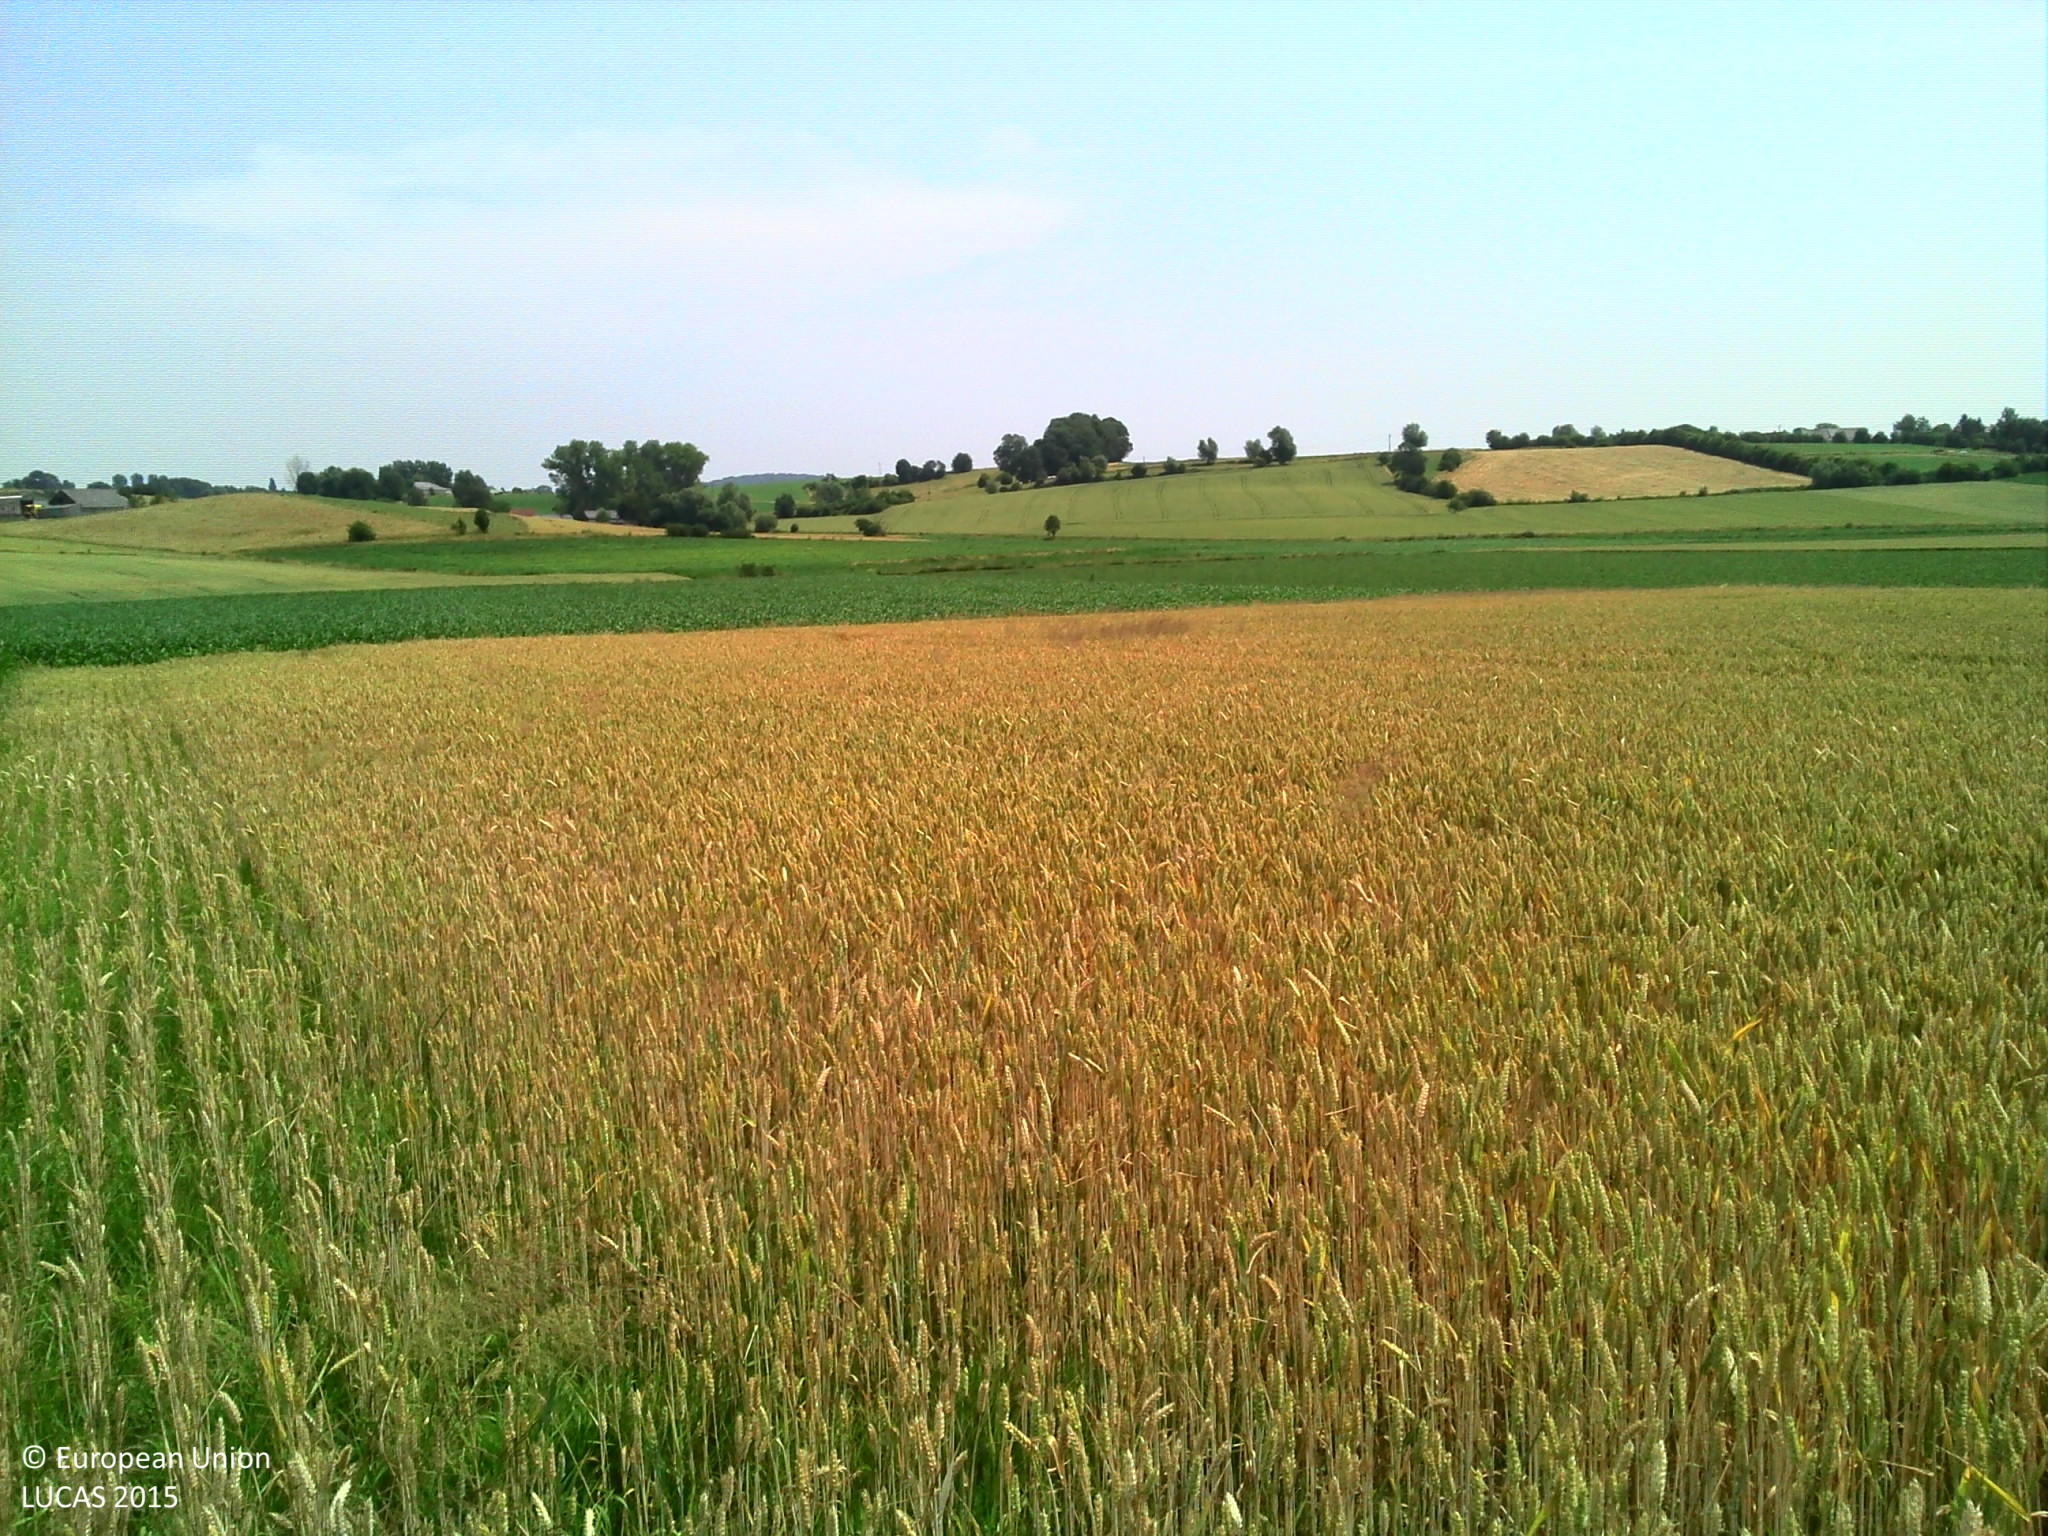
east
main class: Cropland
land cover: Common wheat
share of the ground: > 75 %
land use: Agriculture (excluding fallow land and kitchen gardens)
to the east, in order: Common wheat; Grass margins; Ditches and canals; Grass margins; Maize
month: July
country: BE
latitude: 50.6287
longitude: 3.4750
